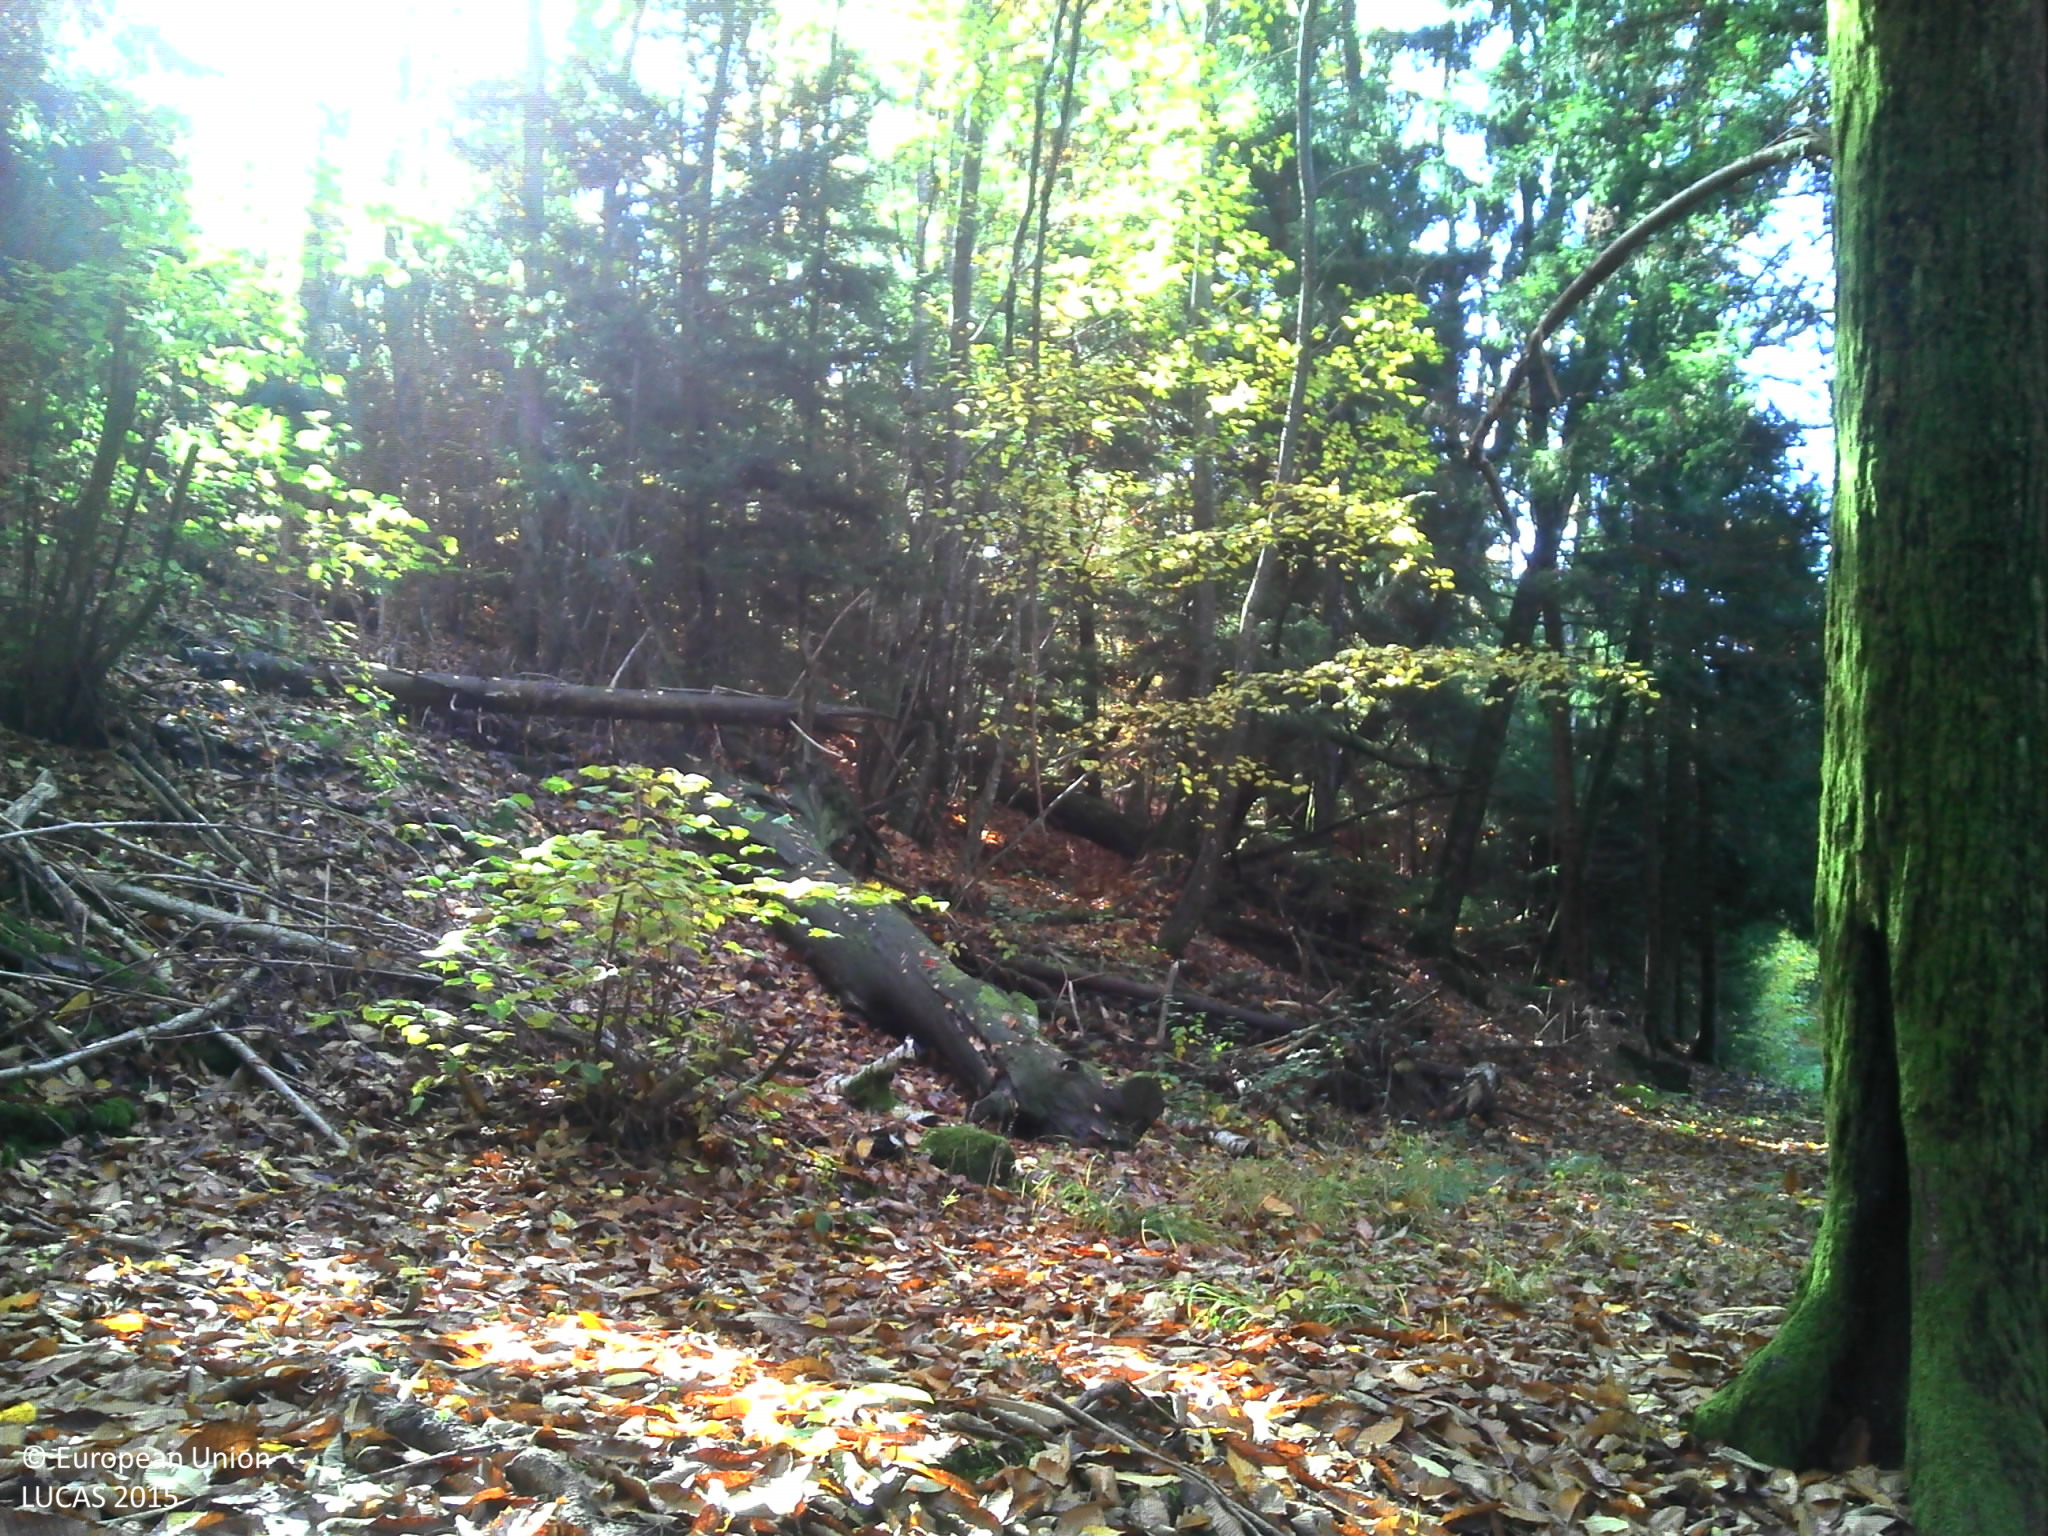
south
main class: Woodland
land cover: Spruce dominated mixed woodland
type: hemiboreal forest and nemoral coniferous forest and mixed broadleaved-coniferous forest
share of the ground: > 75 %
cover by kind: coniferous forest trees 45 %, broadleaved forest trees 45 %, unconsolidated bare surface 10 %
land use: Forestry
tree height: > 5 m
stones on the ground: < 10 %
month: October
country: FR
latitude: 45.4705
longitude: 6.1547
